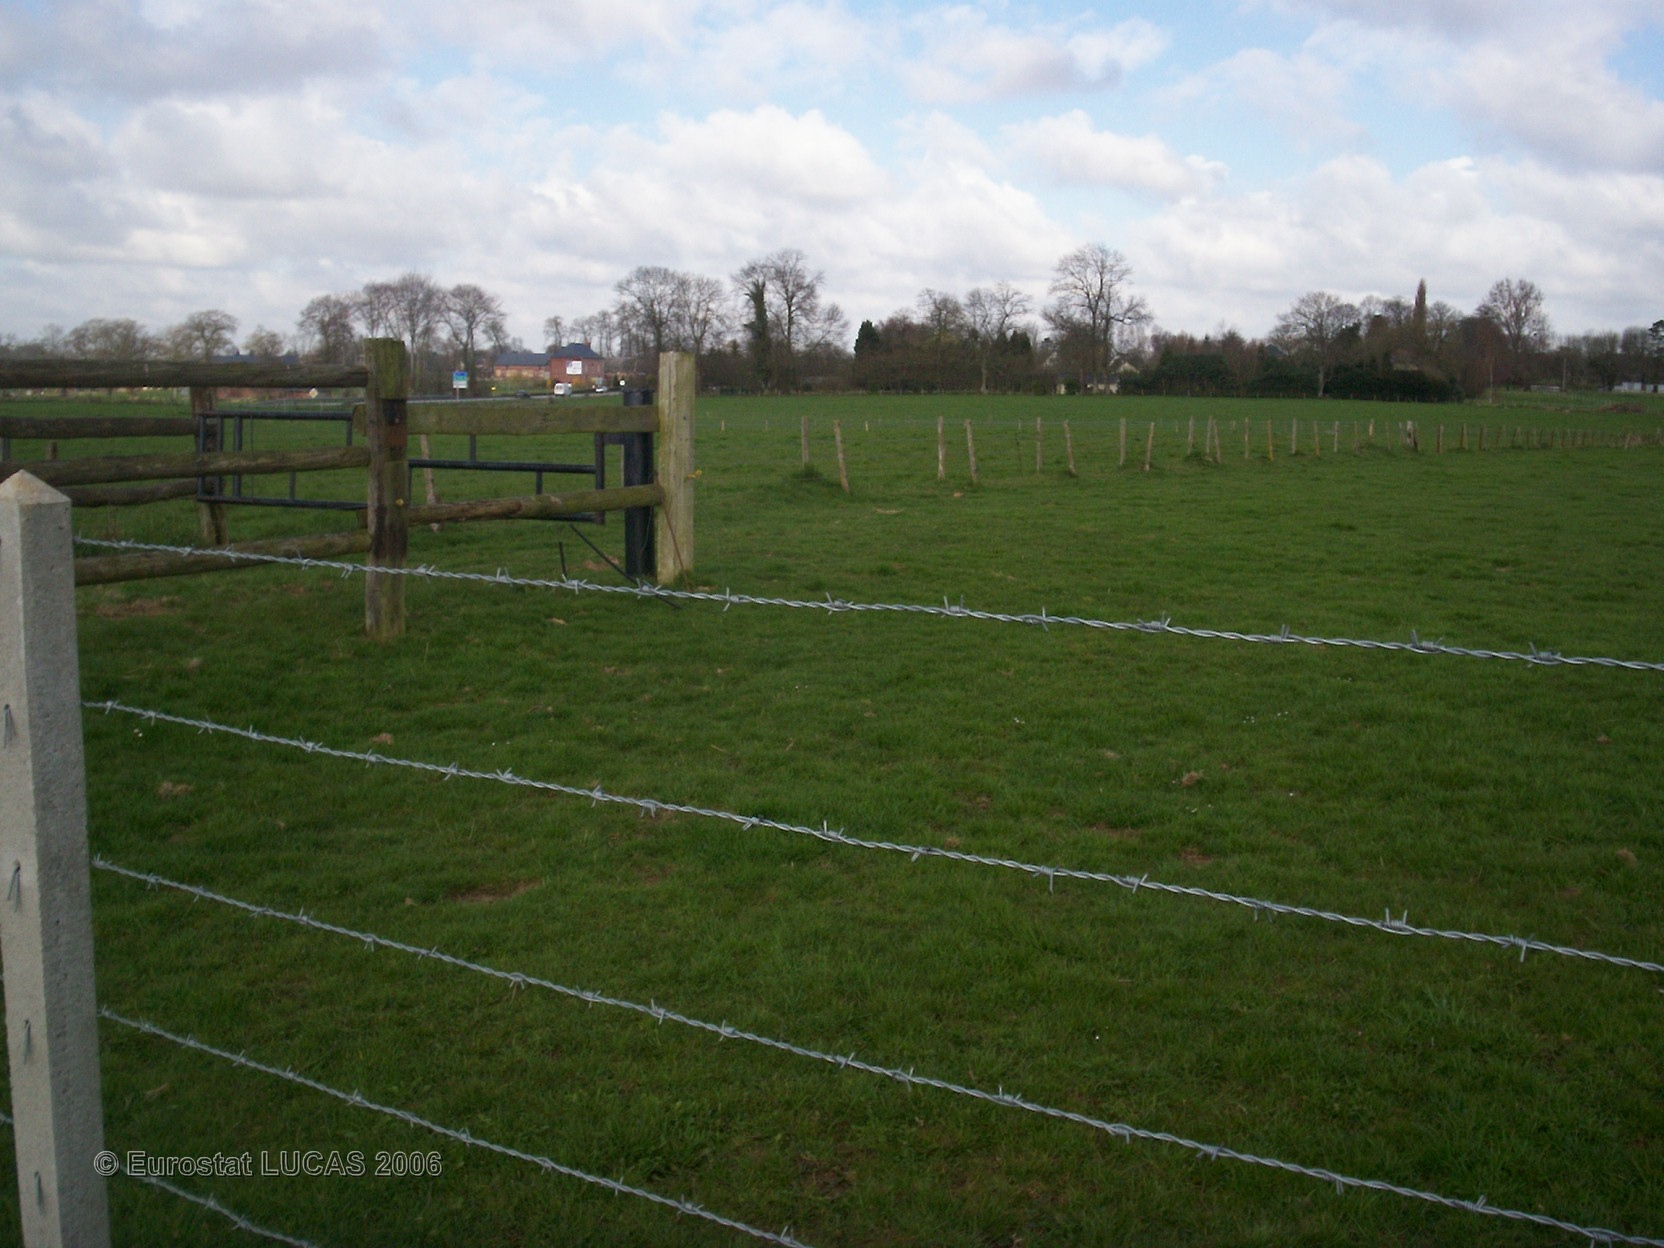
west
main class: Grassland
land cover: Grassland without tree/shrub cover
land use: Agriculture (excluding fallow land and kitchen gardens)
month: April
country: FR
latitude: 49.5679
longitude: 0.9201
